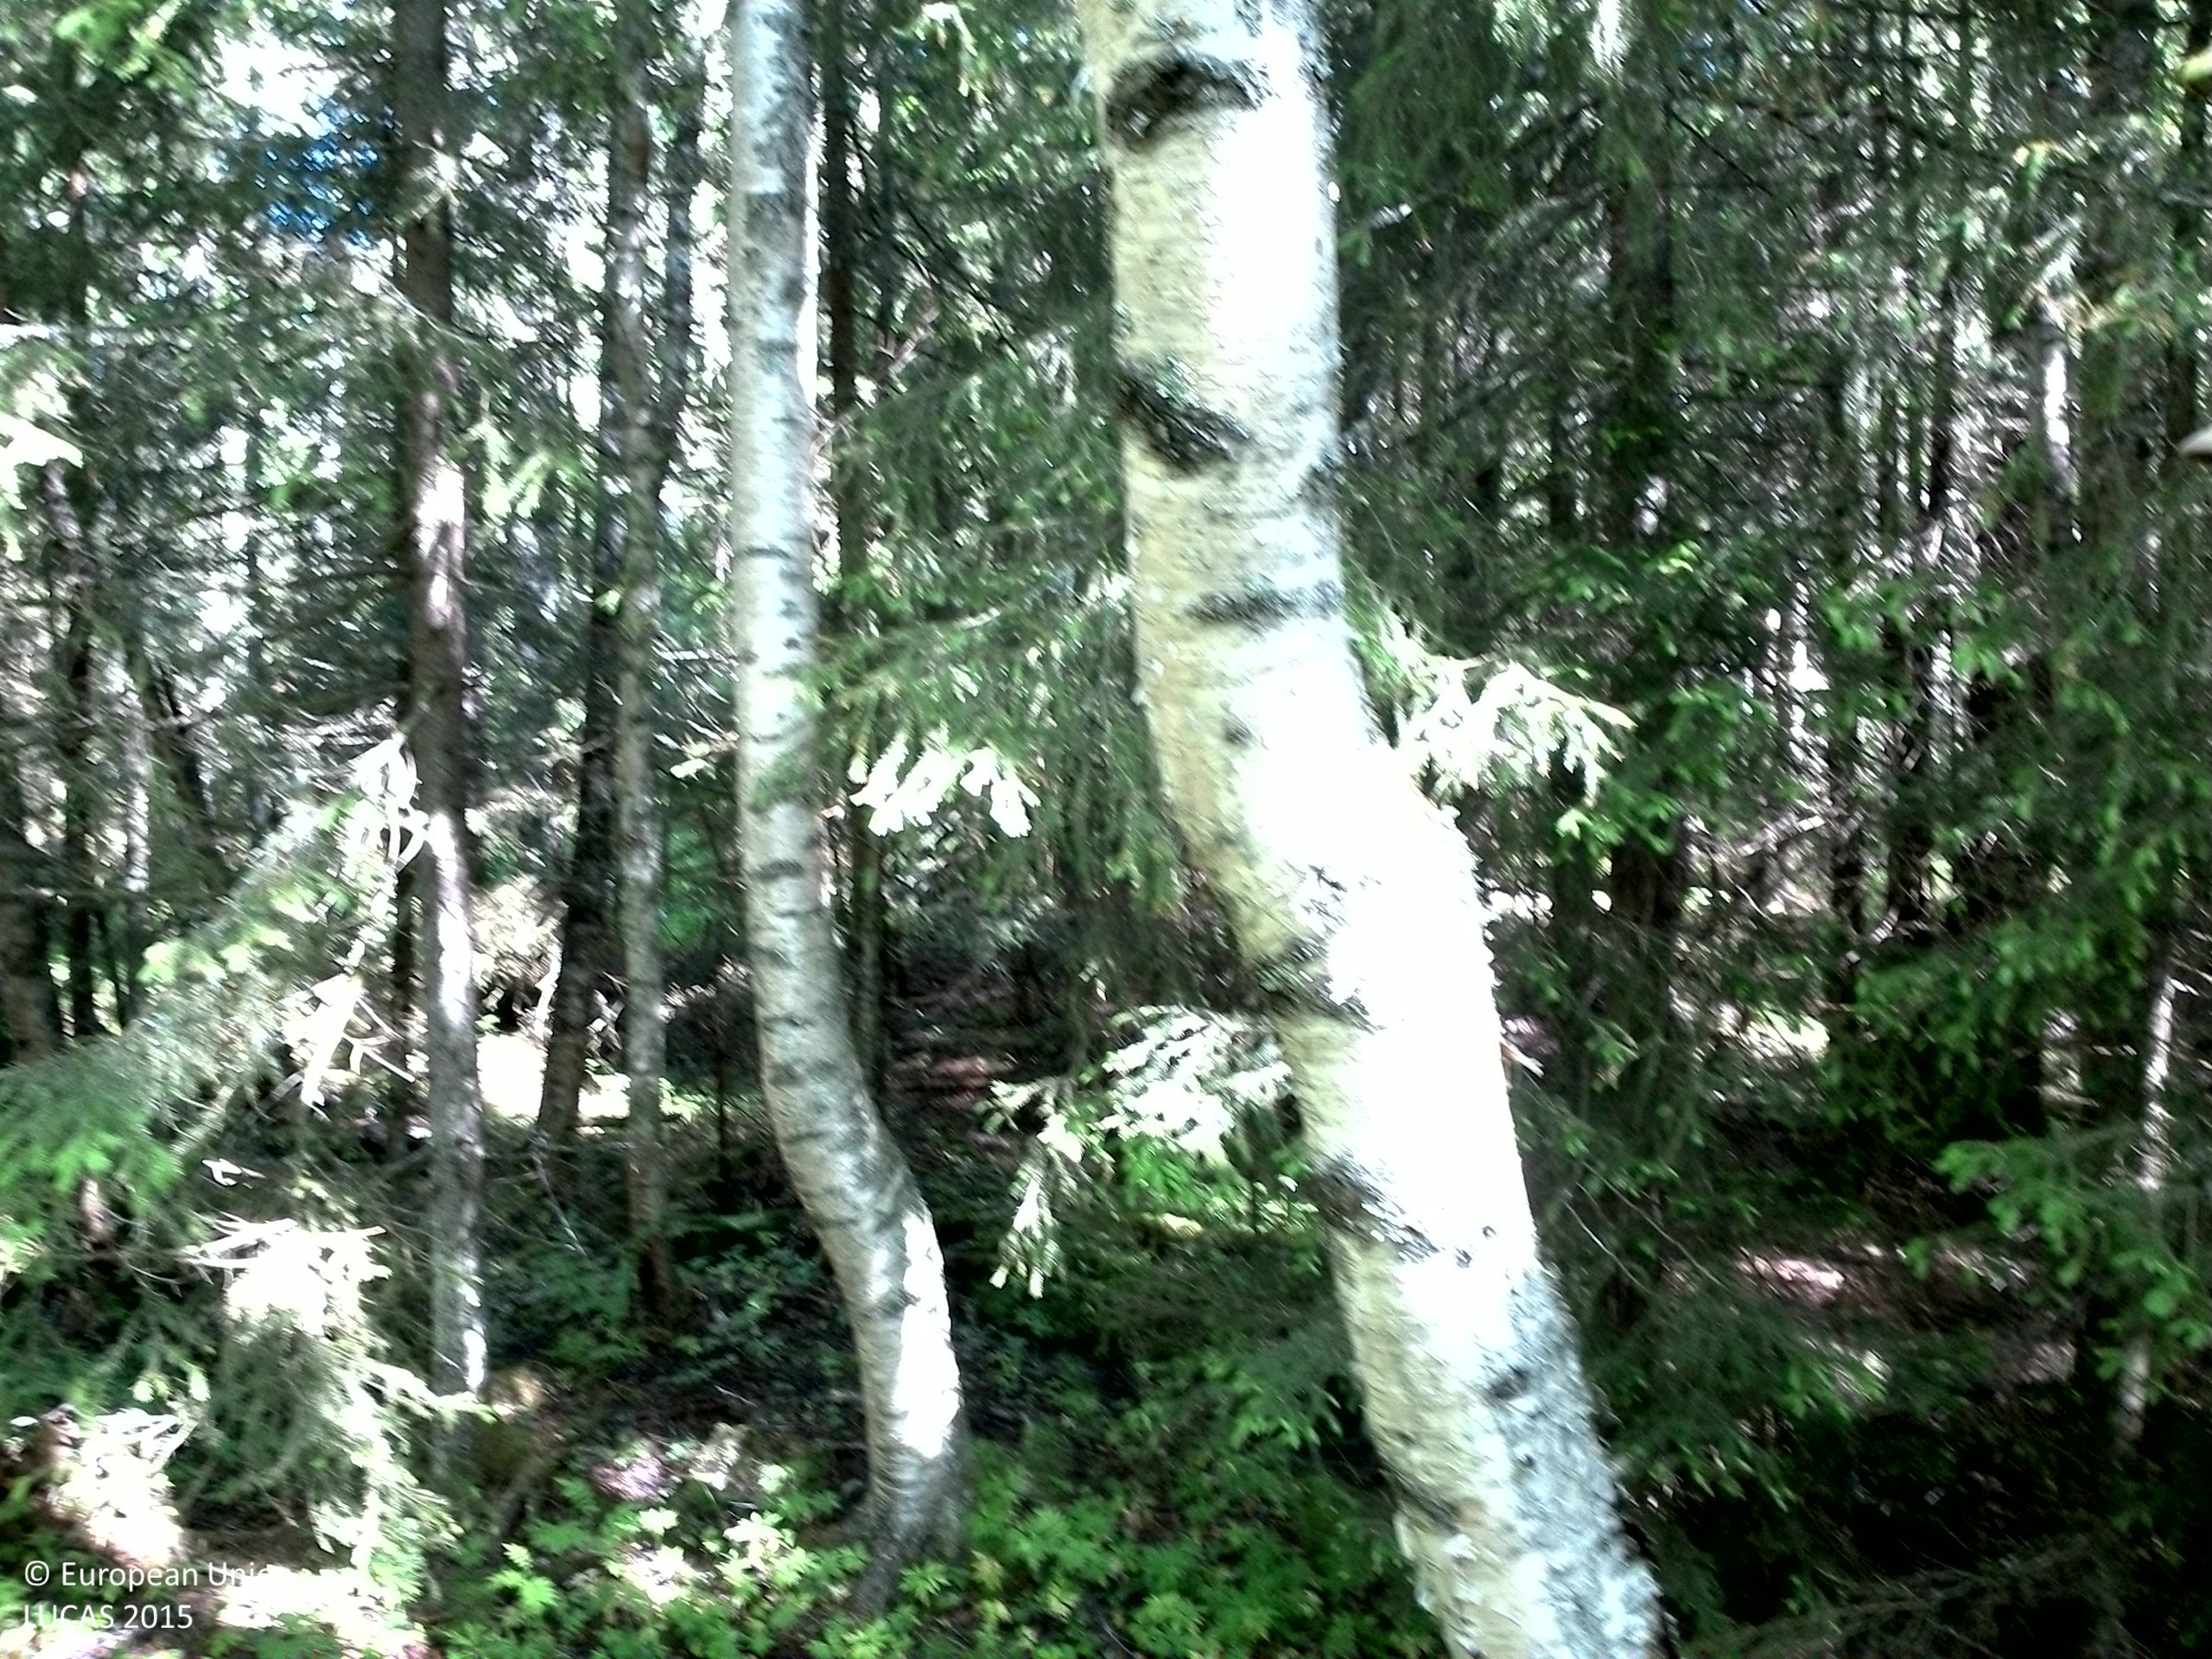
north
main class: Woodland
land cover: Spruce dominated mixed woodland
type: boreal forest
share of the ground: > 75 %
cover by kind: coniferous forest trees 60 %, broadleaved forest trees 30 %, herbaceous plants 10 %
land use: Forestry
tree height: > 5 m
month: June
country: SE
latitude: 62.7132
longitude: 17.8984
